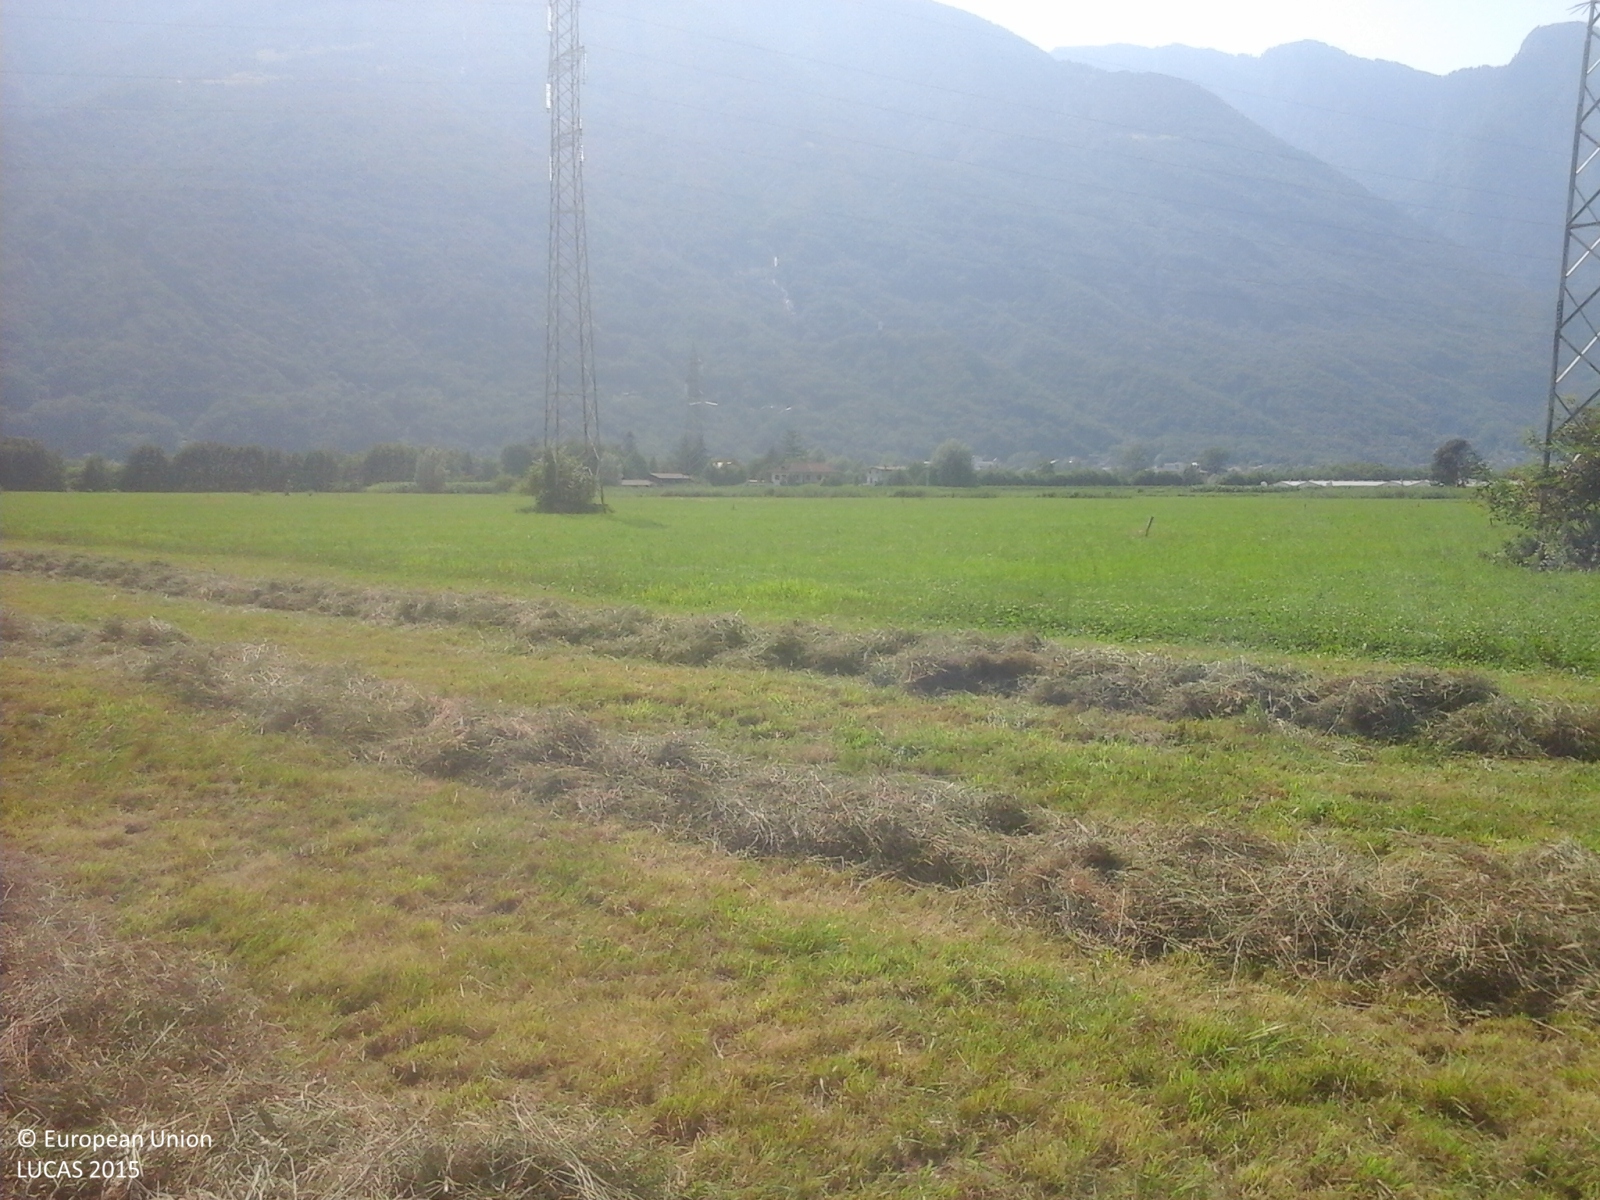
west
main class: Grassland
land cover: Grassland without tree/shrub cover
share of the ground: > 75 %
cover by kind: herbaceous plants 100 %
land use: Agriculture (excluding fallow land and kitchen gardens)
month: July
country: IT
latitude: 46.2415
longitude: 9.4172
